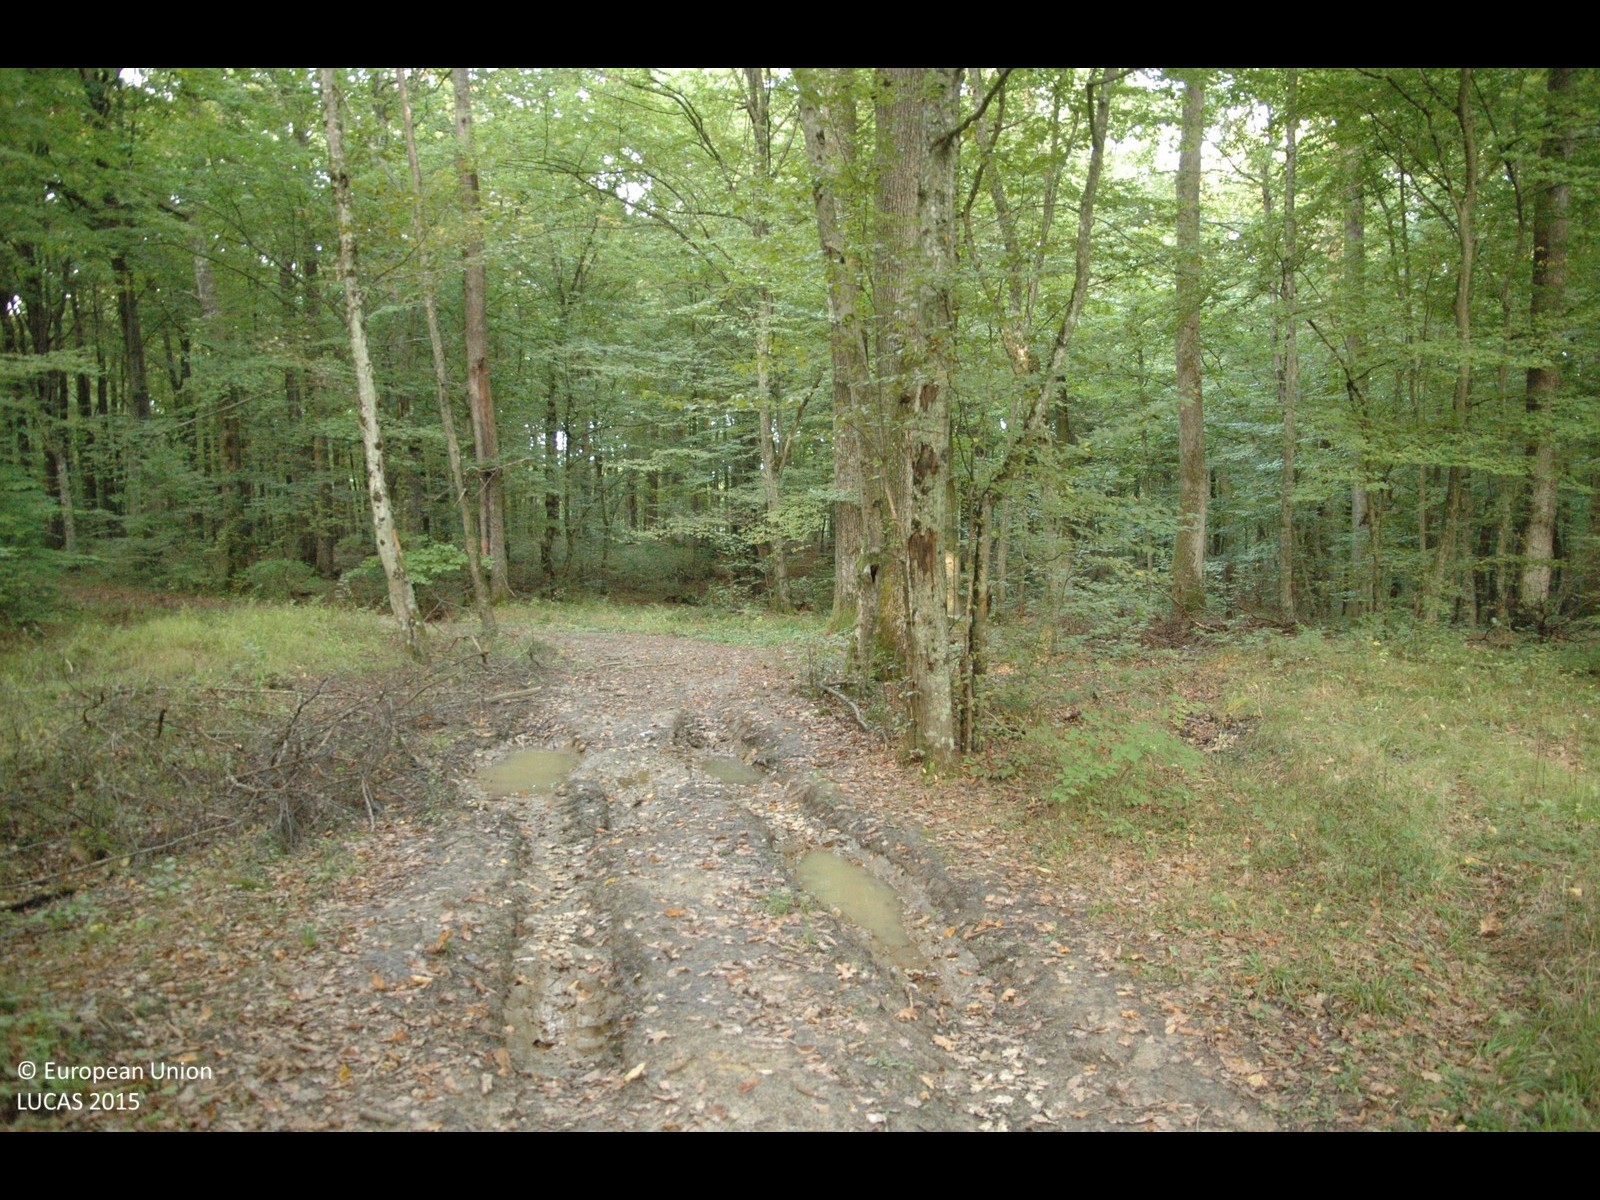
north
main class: Woodland
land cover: Broadleaved woodland
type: mesophytic deciduous forest
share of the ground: > 75 %
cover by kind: broadleaved forest trees 100 %
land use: Forestry
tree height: > 5 m
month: October
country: HR
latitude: 45.5385
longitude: 16.2087
